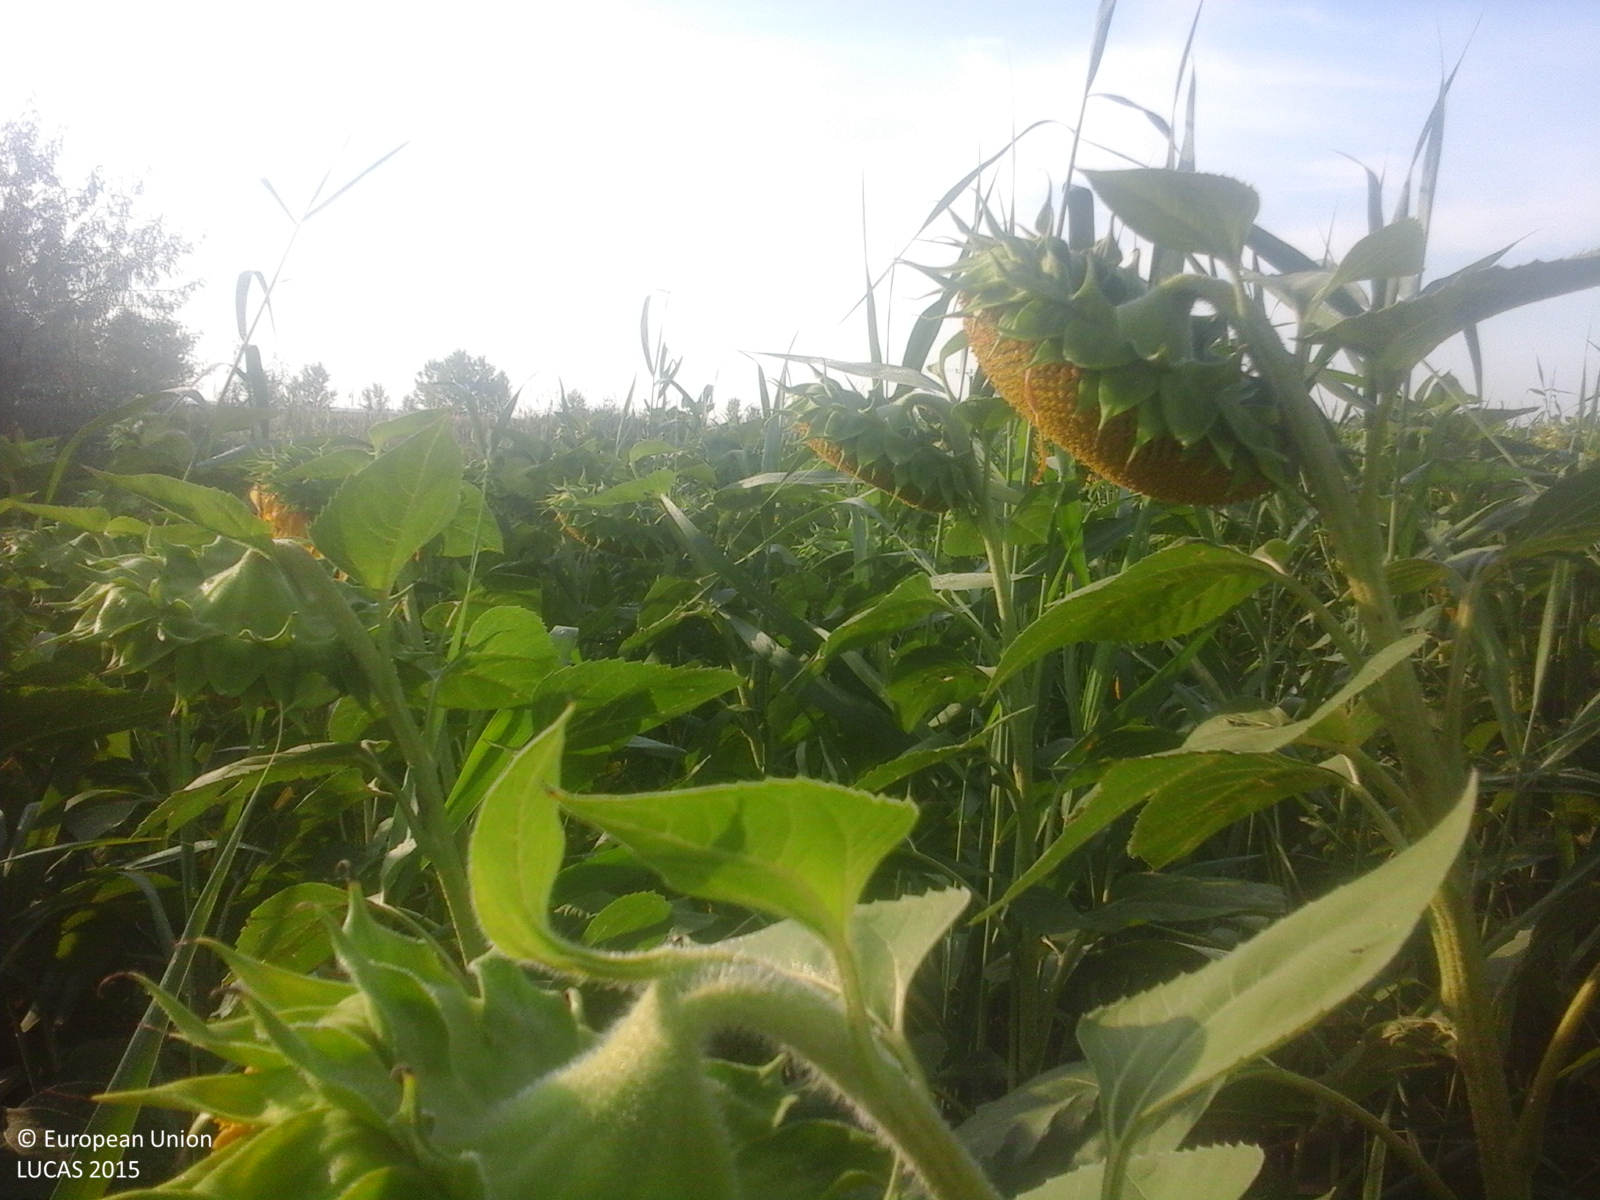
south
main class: Cropland
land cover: Sunflower
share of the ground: > 75 %
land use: Agriculture (excluding fallow land and kitchen gardens)
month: July
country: RO
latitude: 46.7096
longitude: 28.1989
